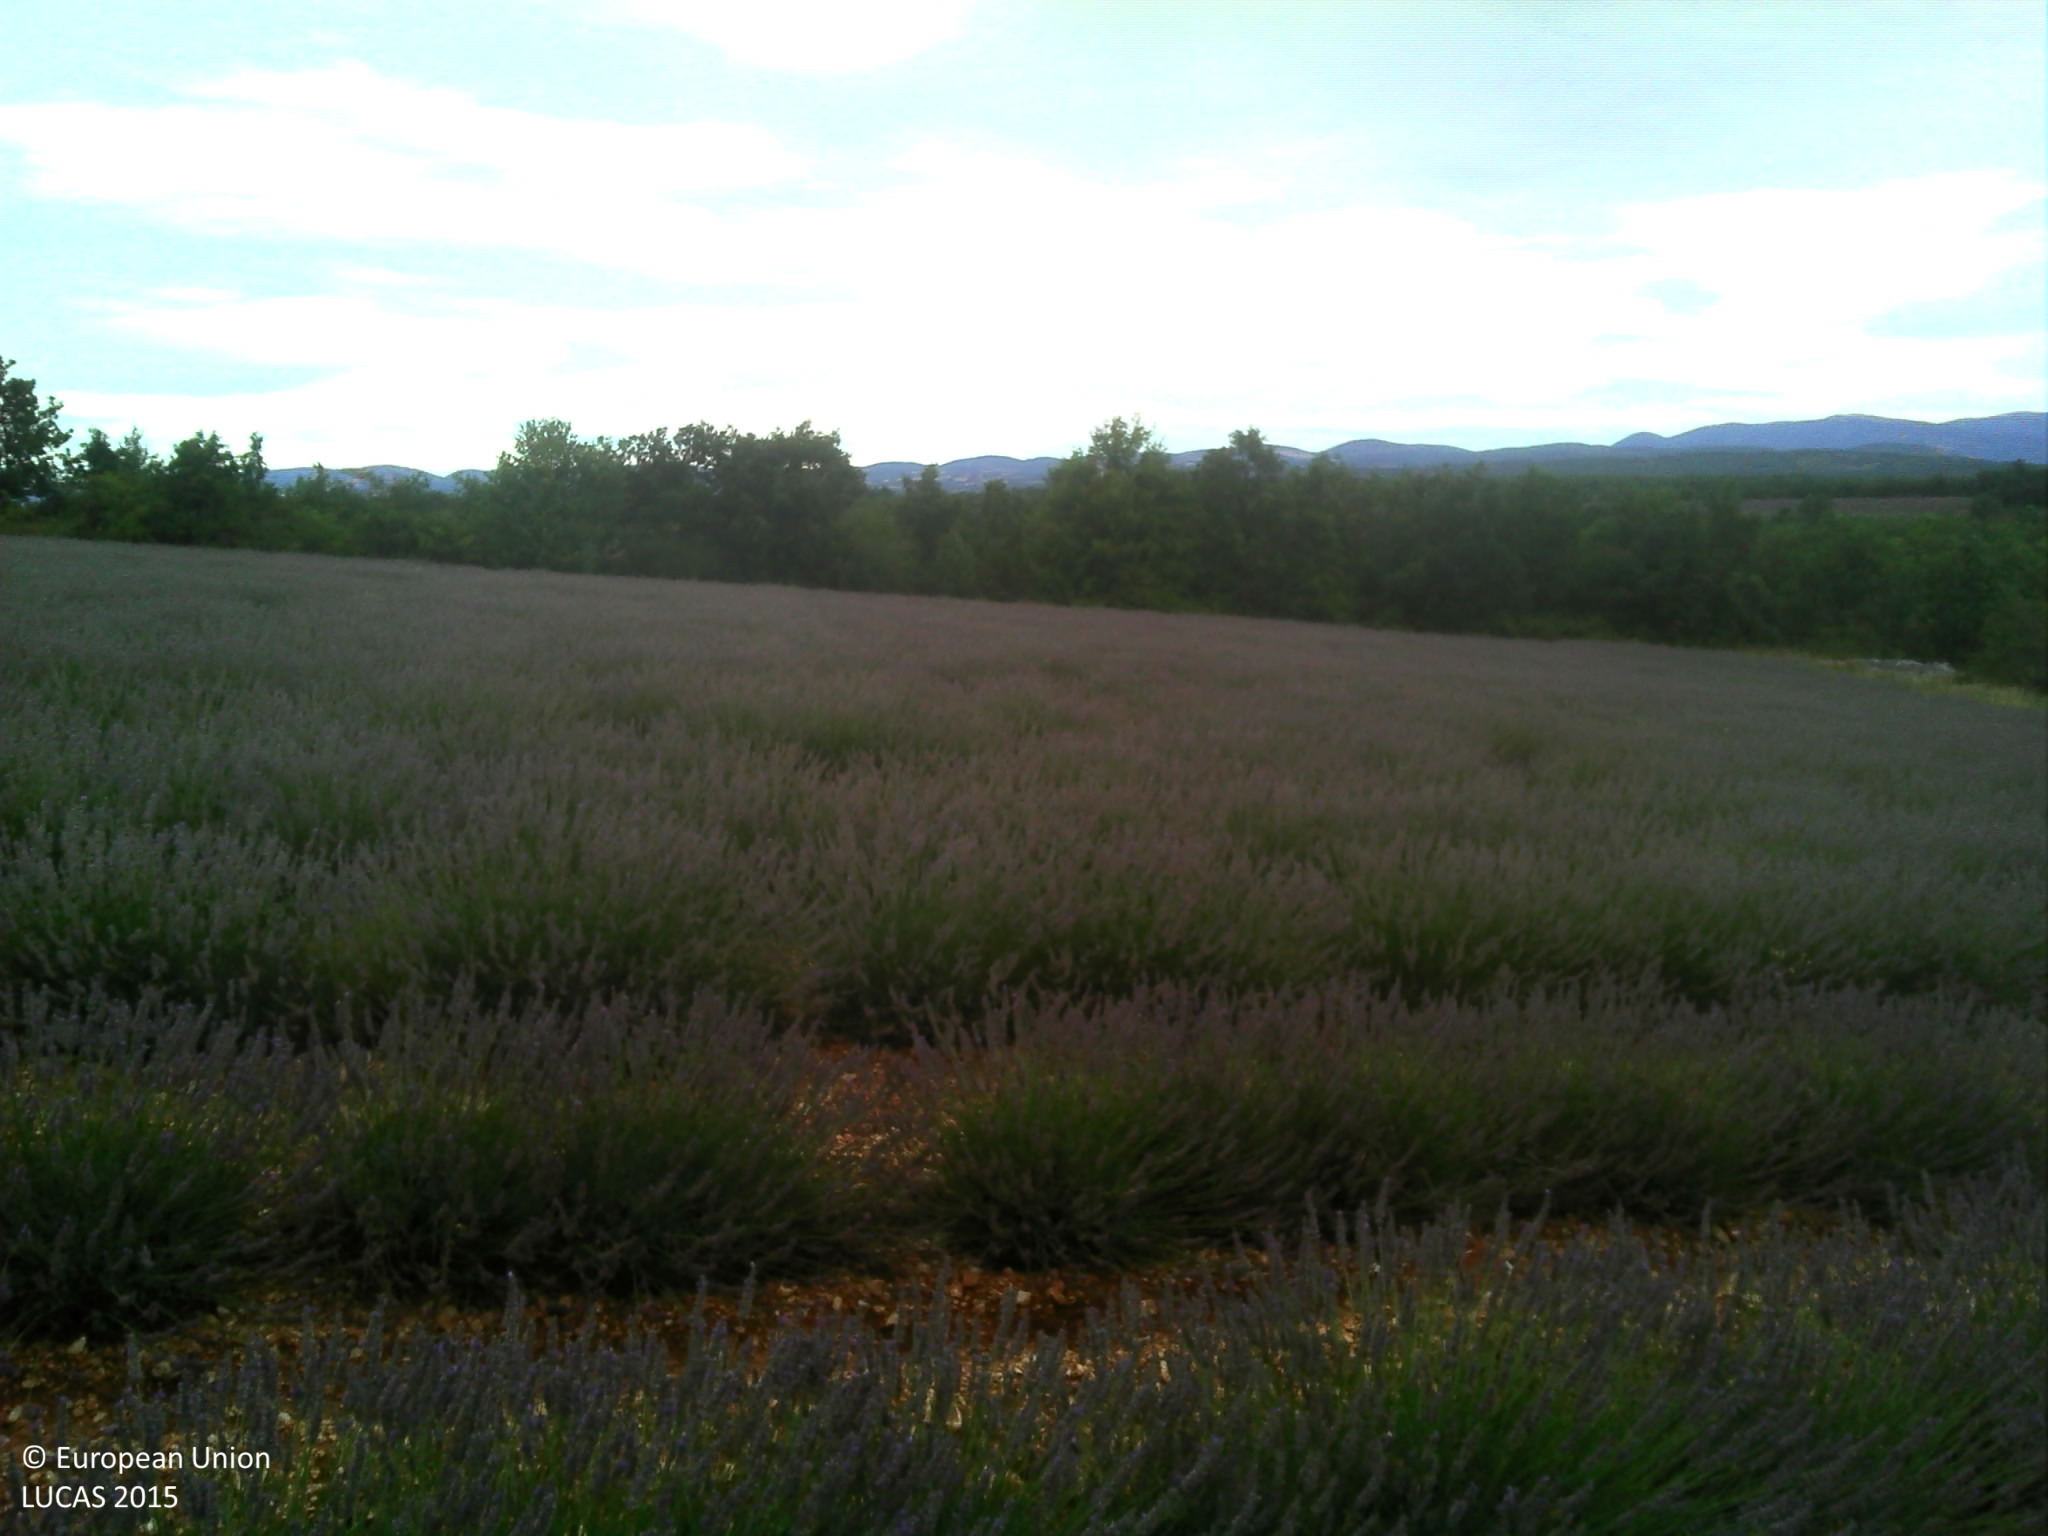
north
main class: Cropland
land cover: Permanent industrial crops
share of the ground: 50 - 75 %
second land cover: Other bare soil
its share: > 75 %
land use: Agriculture (excluding fallow land and kitchen gardens)
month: July
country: FR
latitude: 43.9834
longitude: 5.5325
